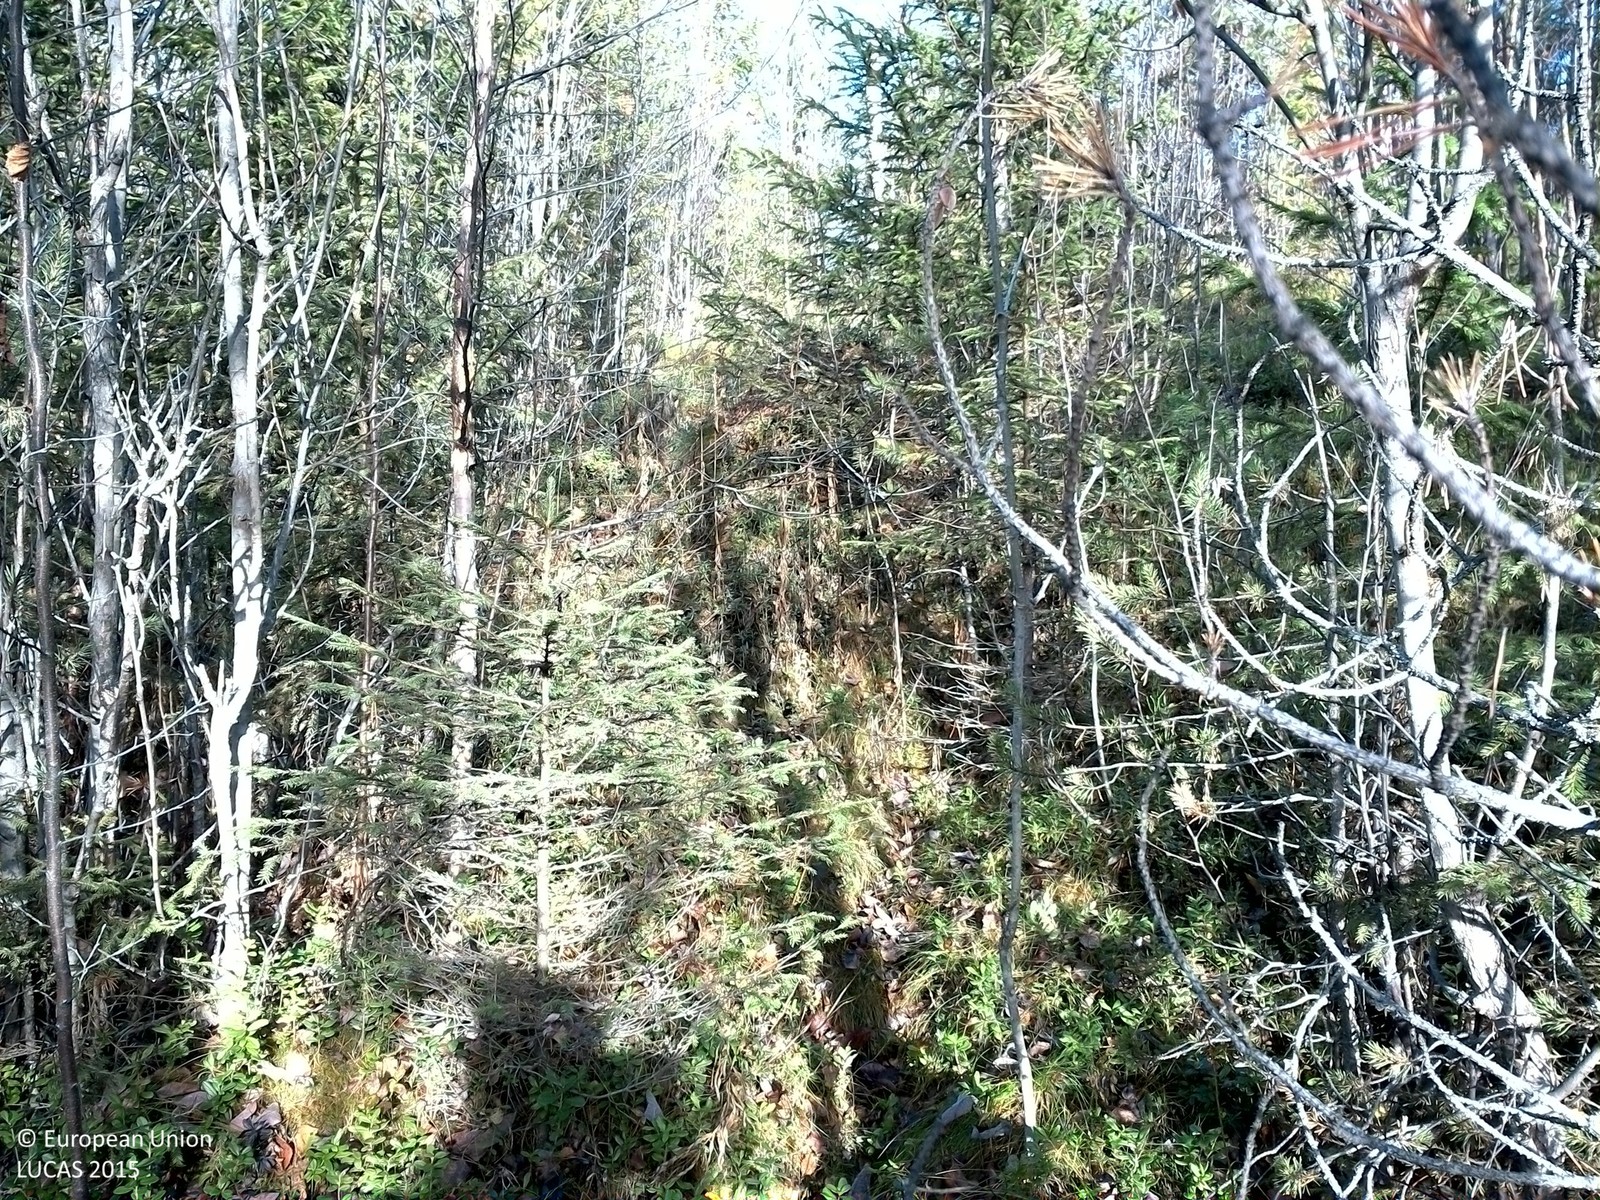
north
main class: Woodland
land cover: Pine dominated mixed woodland
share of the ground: 50 - 75 %
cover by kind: coniferous forest trees 35 %, shrubs 30 %, broadleaved forest trees 20 %, lichens and mosses 10 %, herbaceous plants 5 %
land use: Forestry
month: October
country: SE
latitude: 64.1011
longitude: 16.0653
